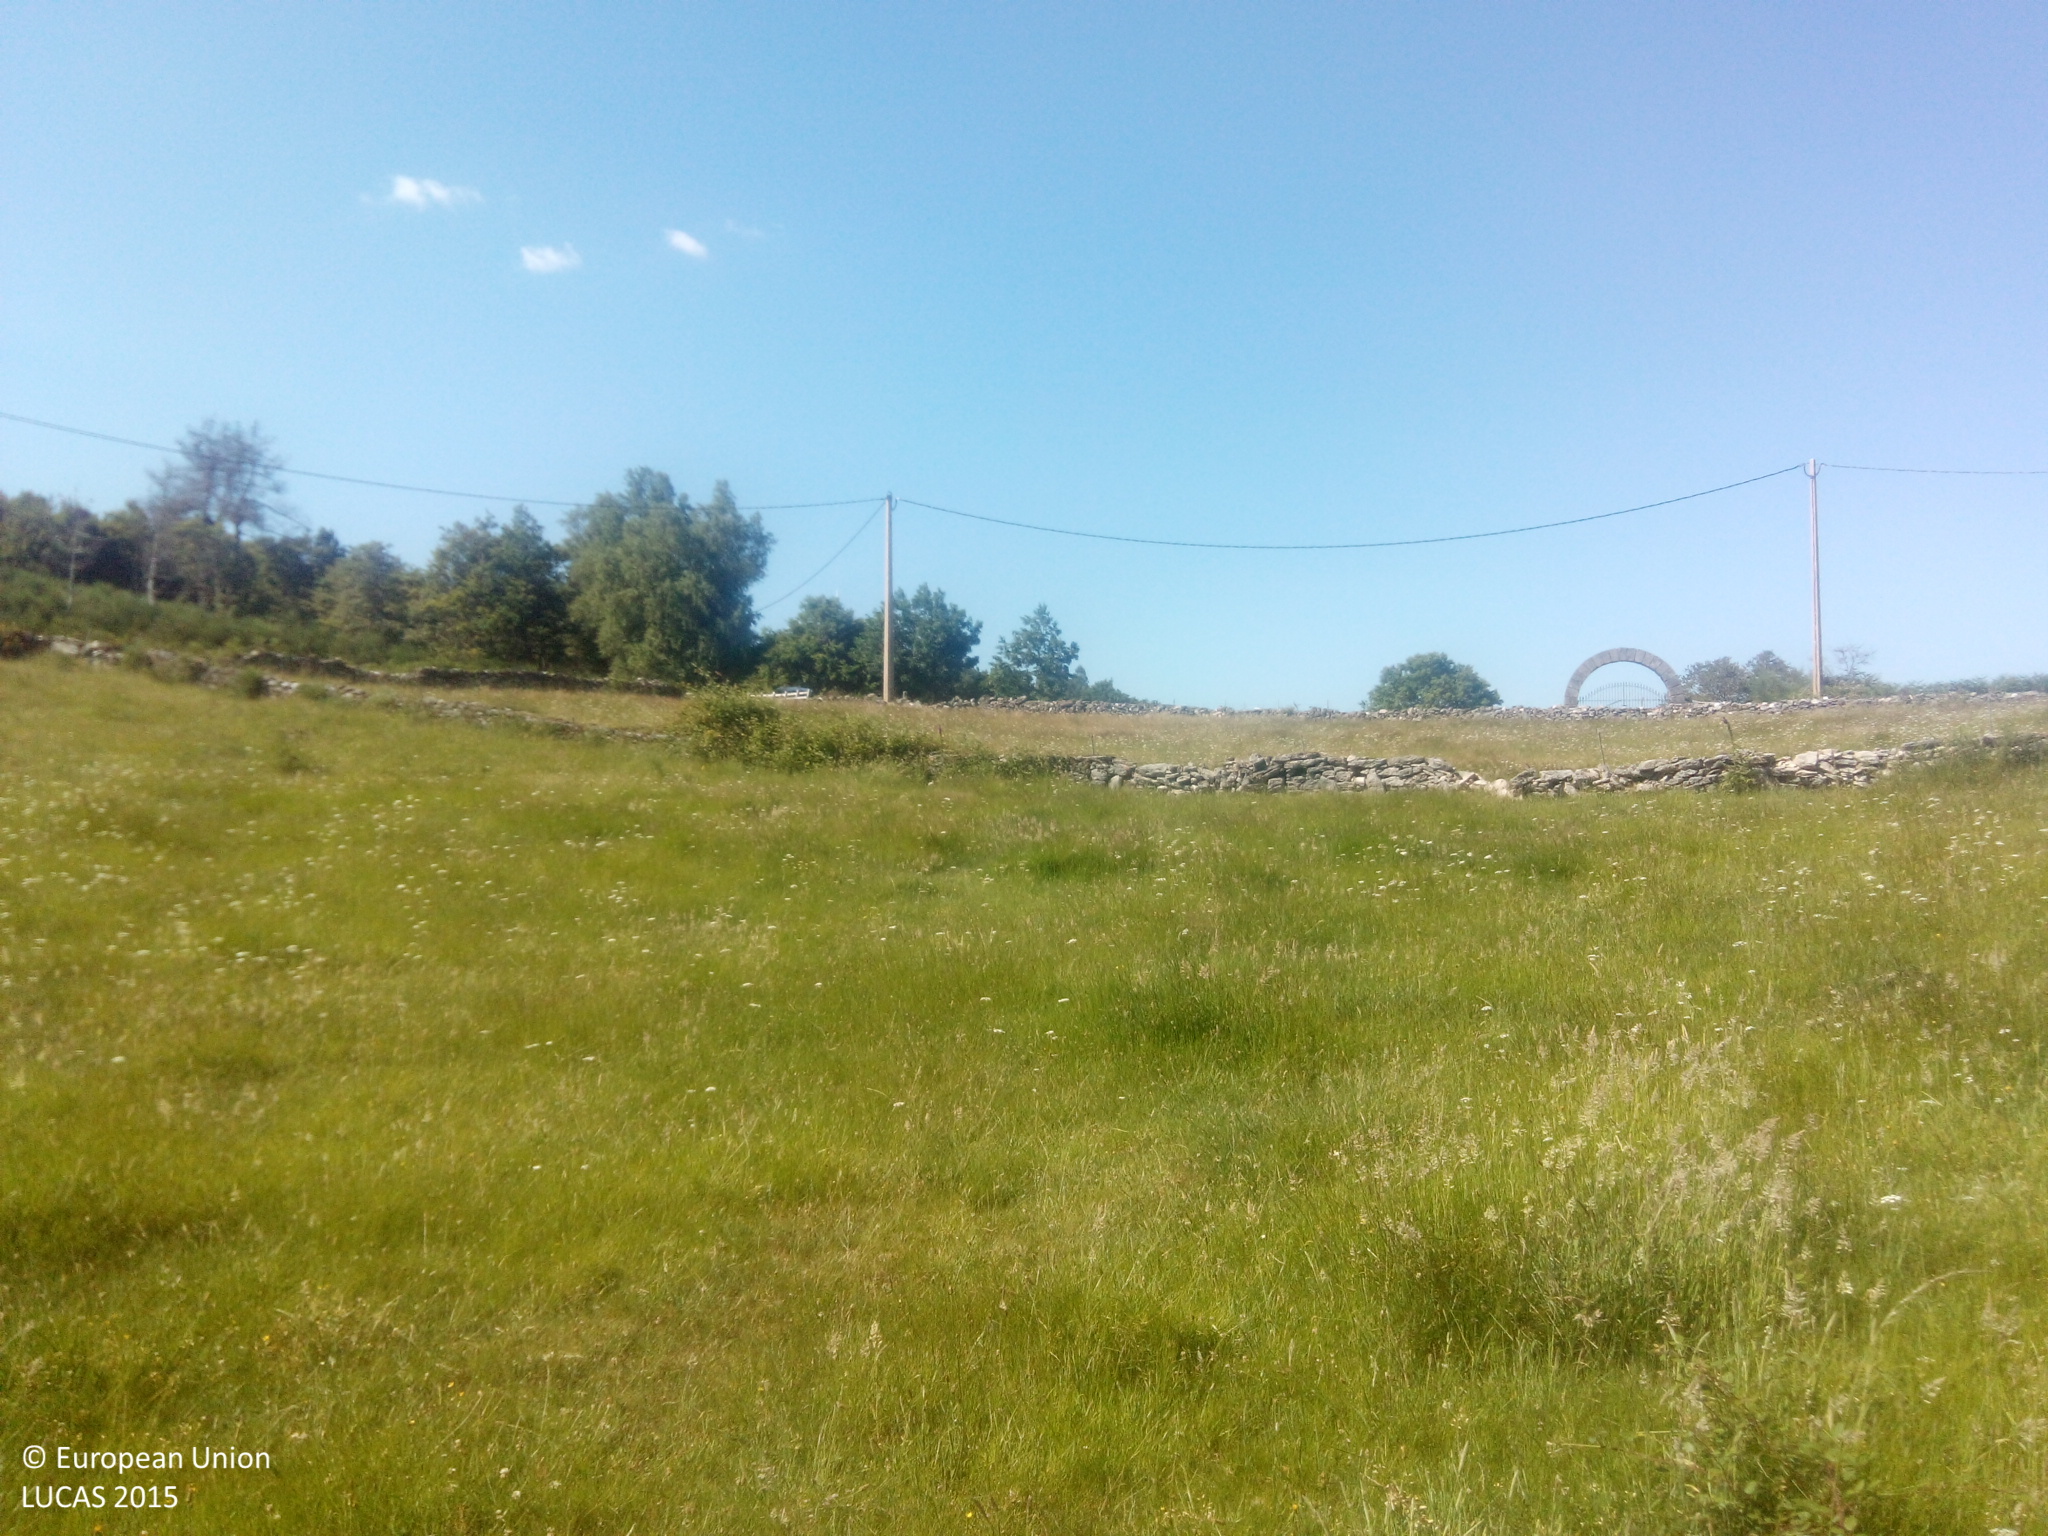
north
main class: Grassland
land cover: Grassland without tree/shrub cover
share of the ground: > 75 %
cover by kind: herbaceous plants 100 %
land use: Agriculture (excluding fallow land and kitchen gardens)
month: June
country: ES
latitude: 42.4313
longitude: -8.3874
